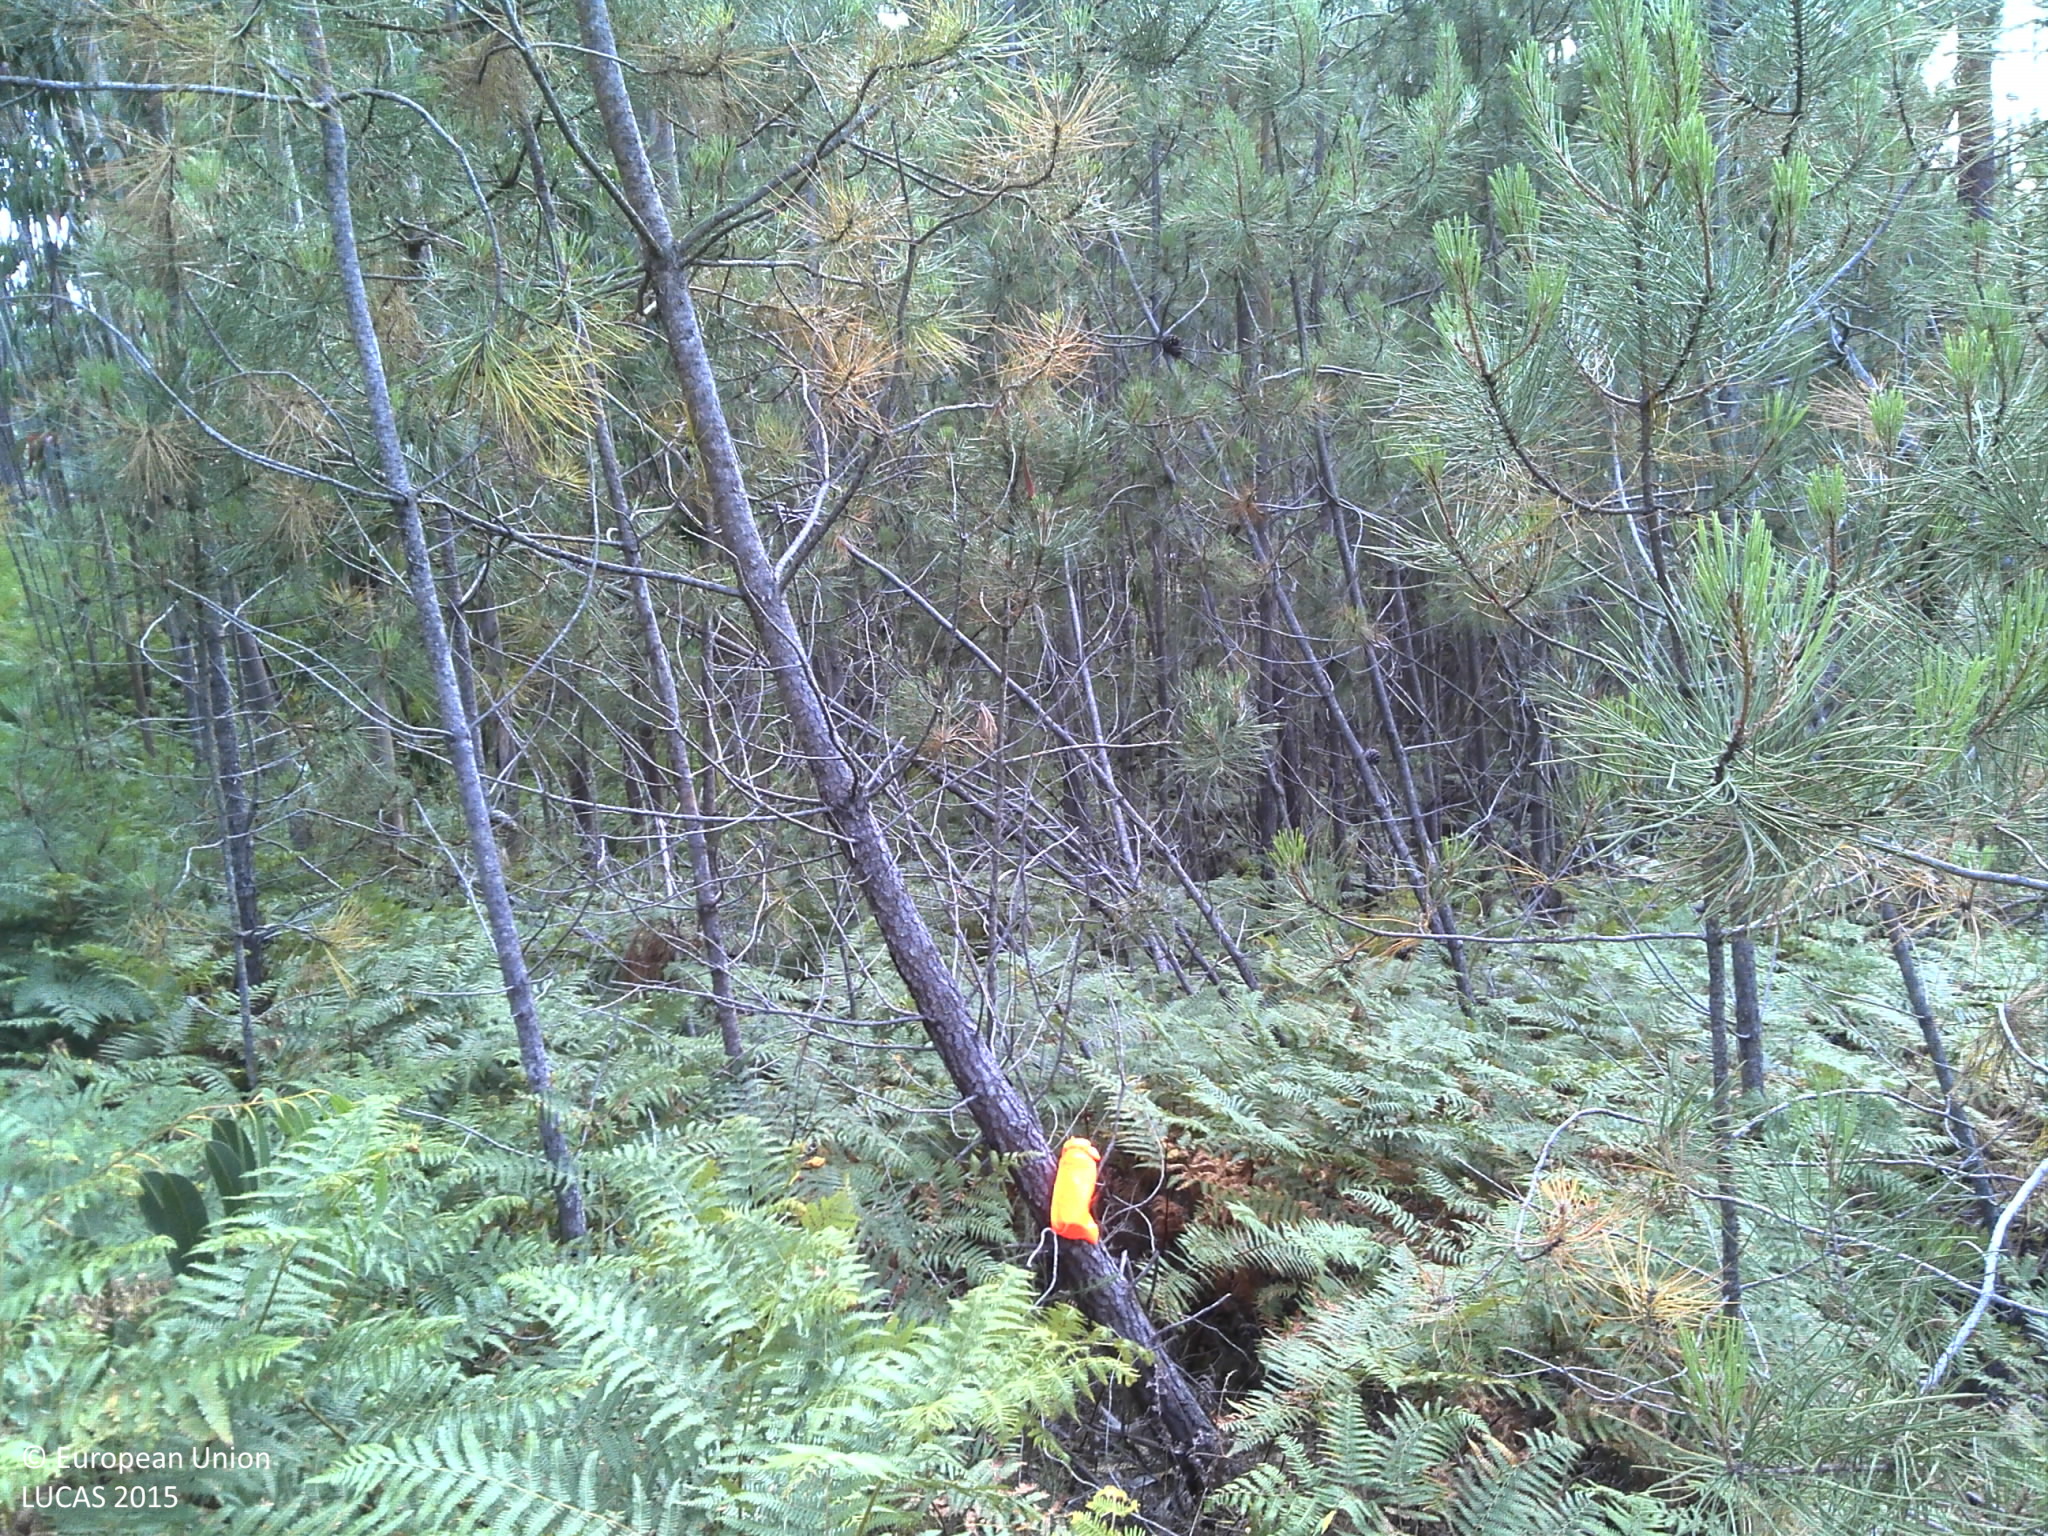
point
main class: Woodland
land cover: Pine dominated coniferous woodland
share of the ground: 50 - 75 %
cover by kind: coniferous forest trees 60 %, shrubs 20 %, unconsolidated bare surface 10 %, broadleaved forest trees 5 %, herbaceous plants 5 %
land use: Forestry
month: June
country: PT
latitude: 39.3641
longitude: -9.2298
